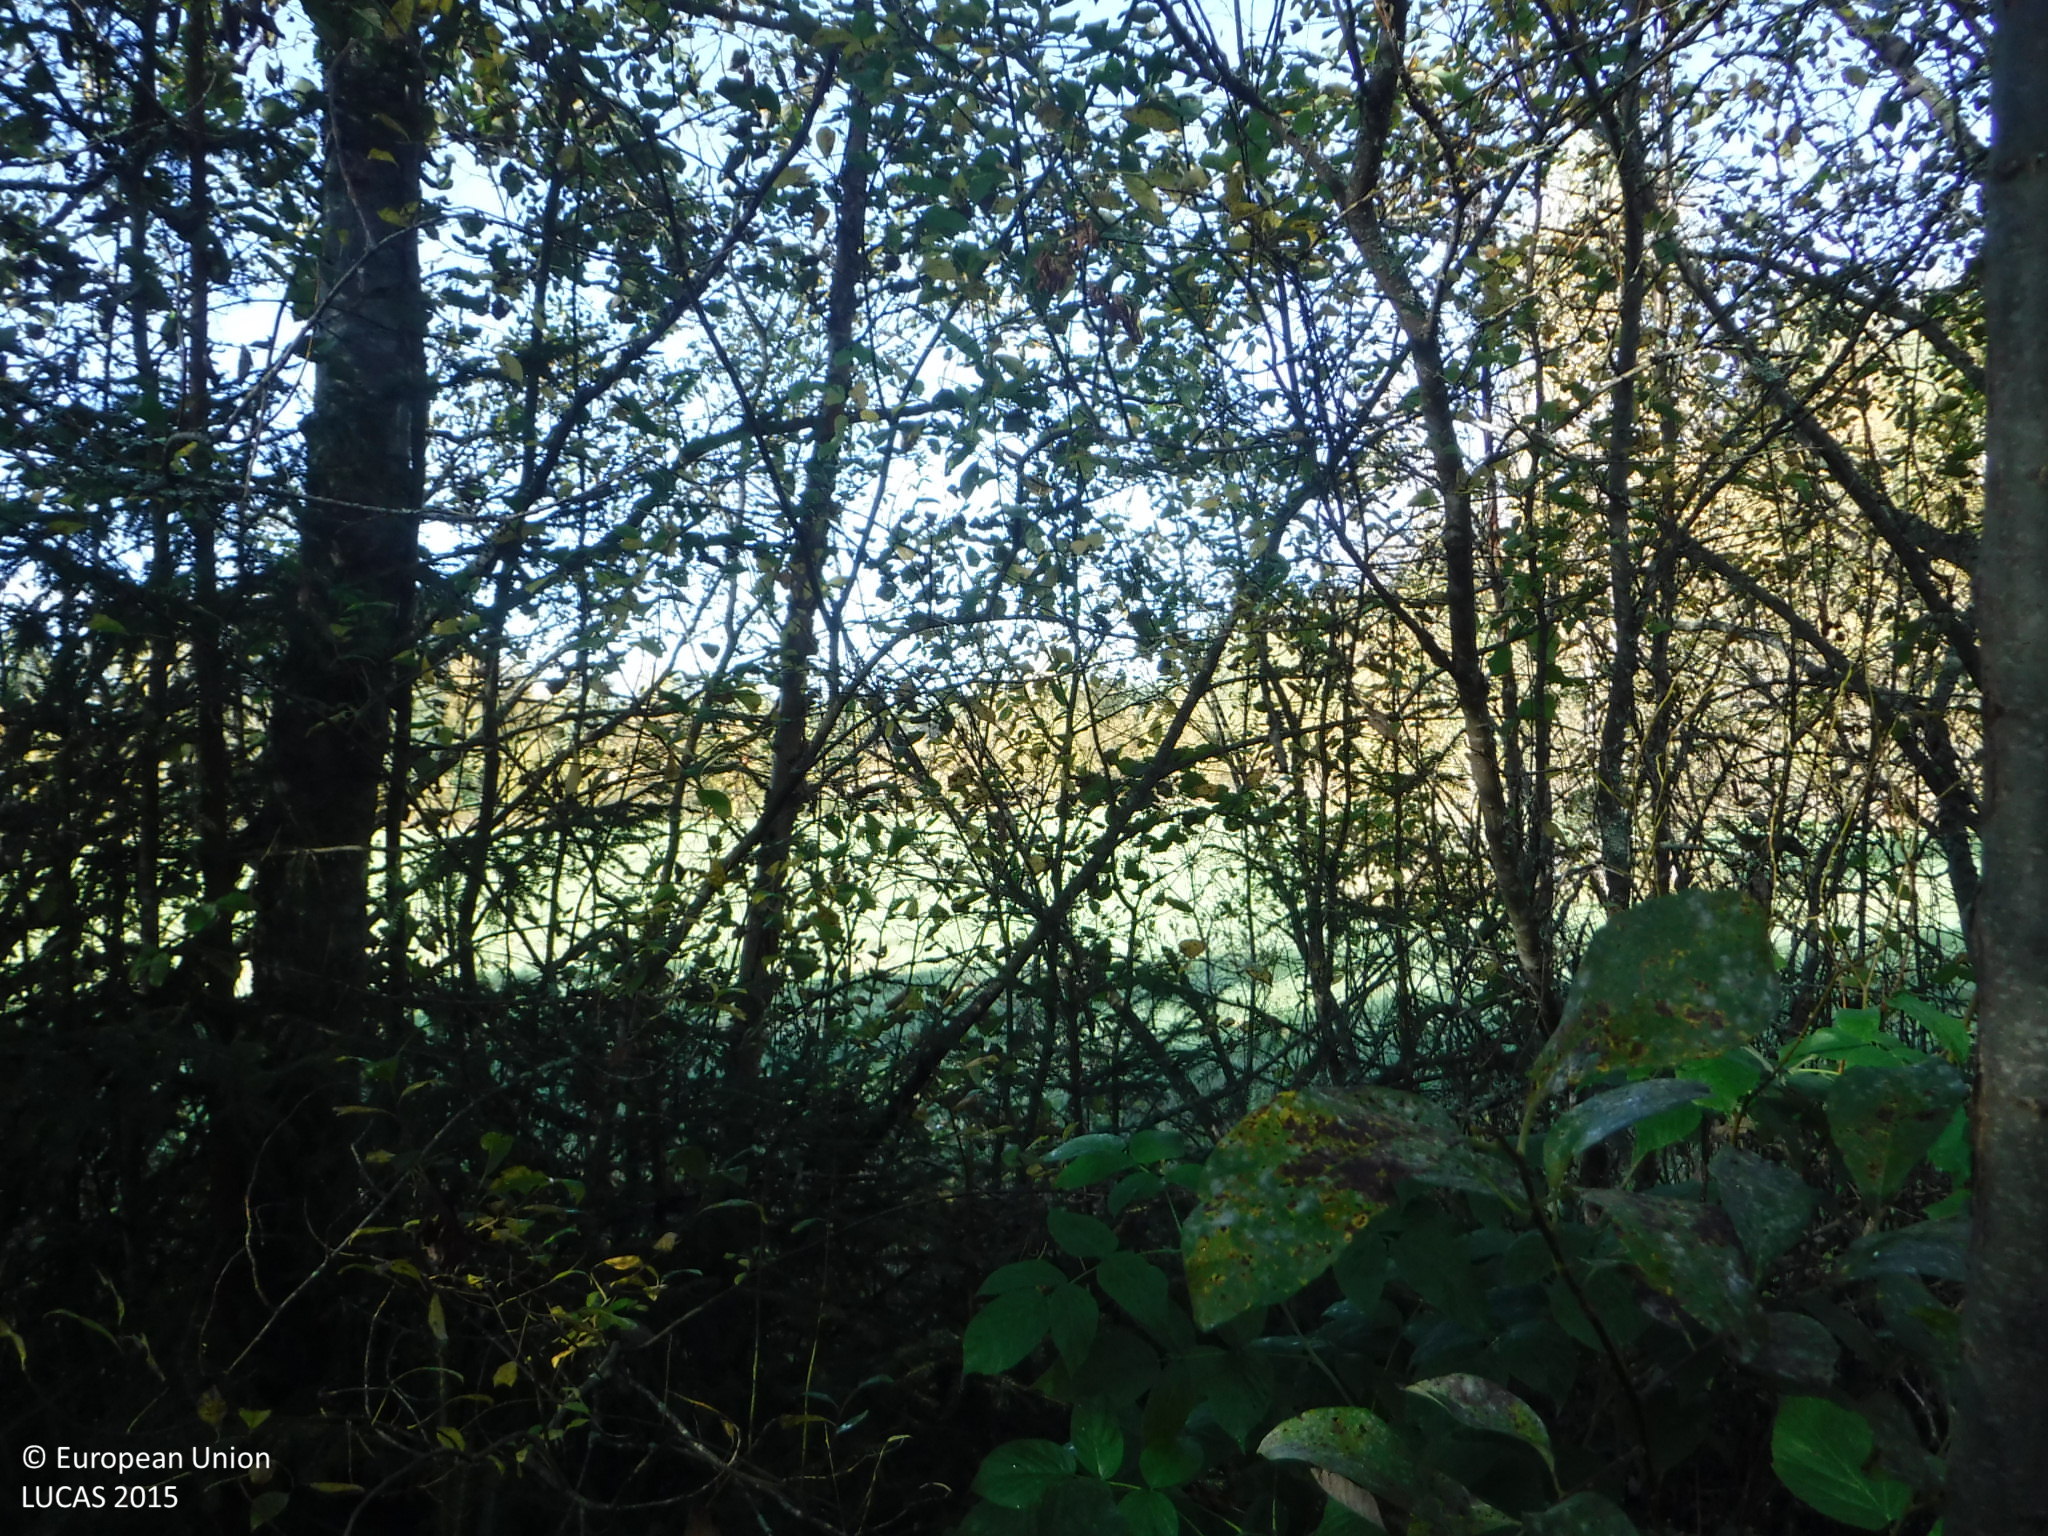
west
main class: Artificial land
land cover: Non built-up linear features
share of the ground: > 75 %
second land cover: Grassland without tree/shrub cover
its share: > 75 %
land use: Road transport
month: September
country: FI
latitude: 62.0870
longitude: 22.5249
